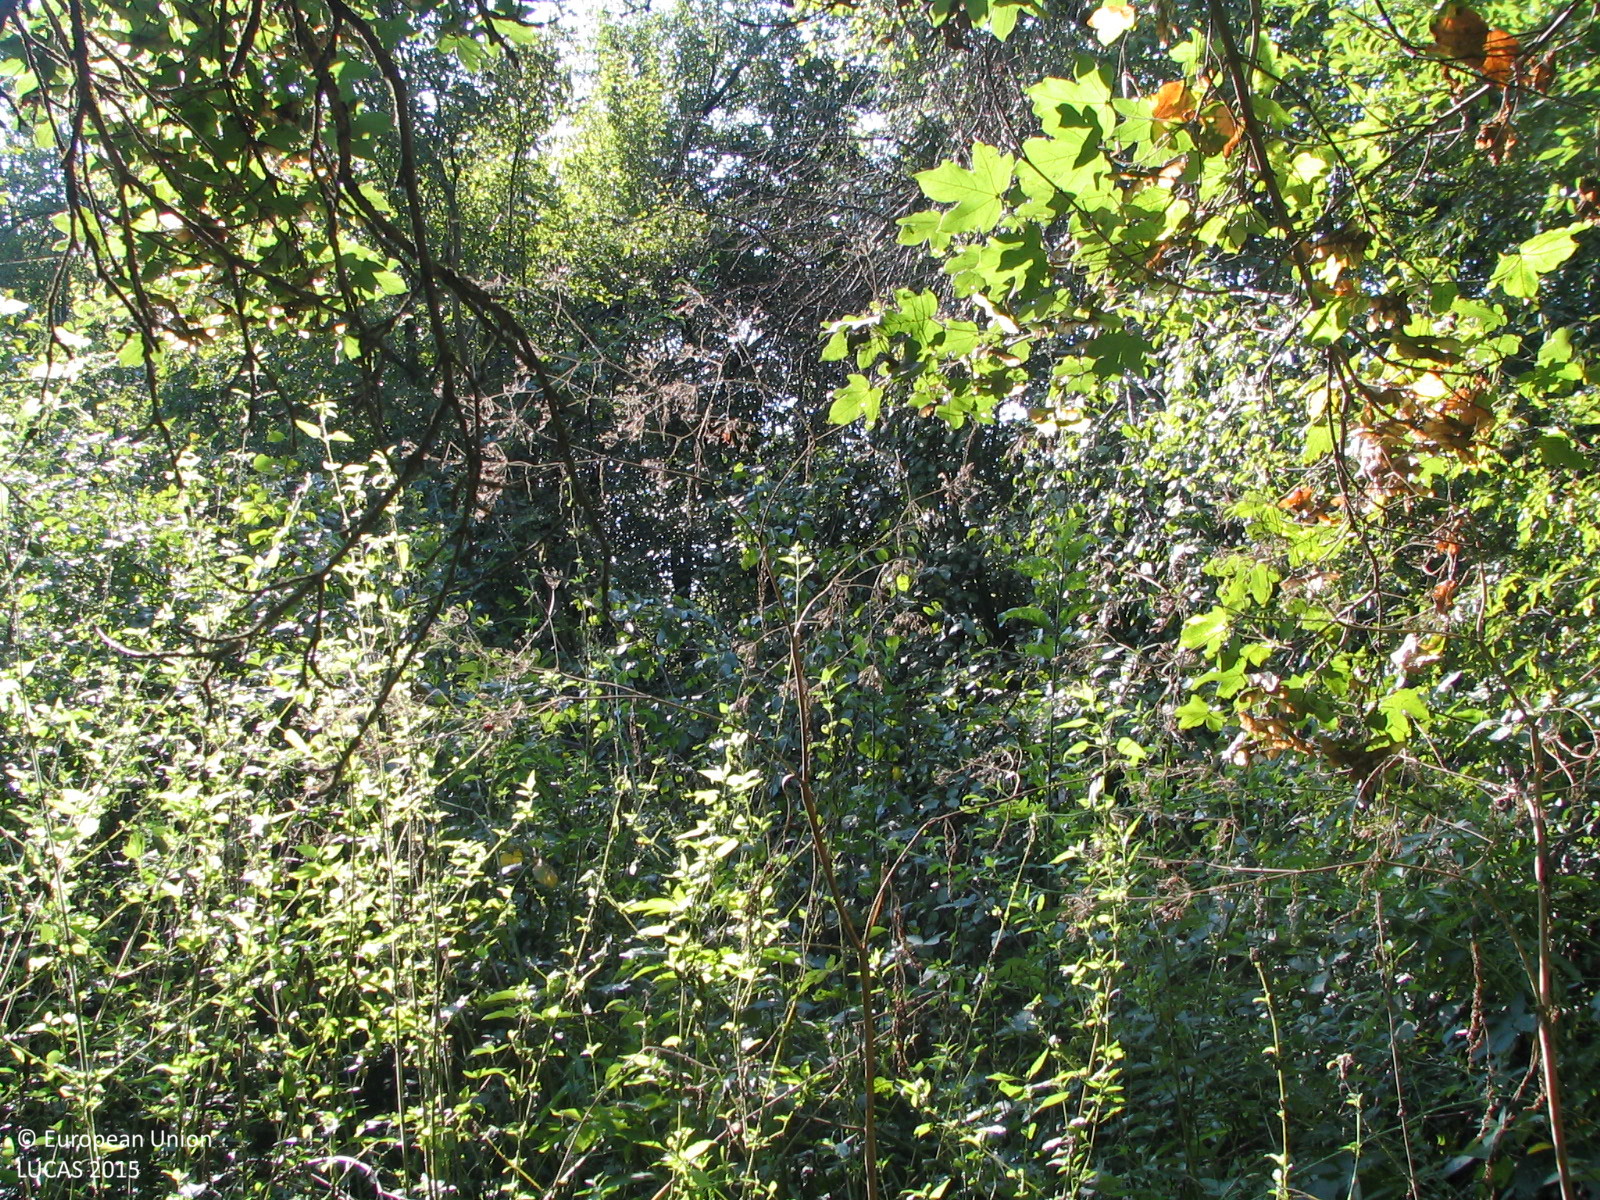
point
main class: Woodland
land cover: Broadleaved woodland
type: mesophytic deciduous forest
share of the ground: 50 - 75 %
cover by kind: broadleaved forest trees 70 %, shrubs 30 %
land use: Forestry
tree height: > 5 m
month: August
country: BG
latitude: 43.1170
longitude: 24.4234
